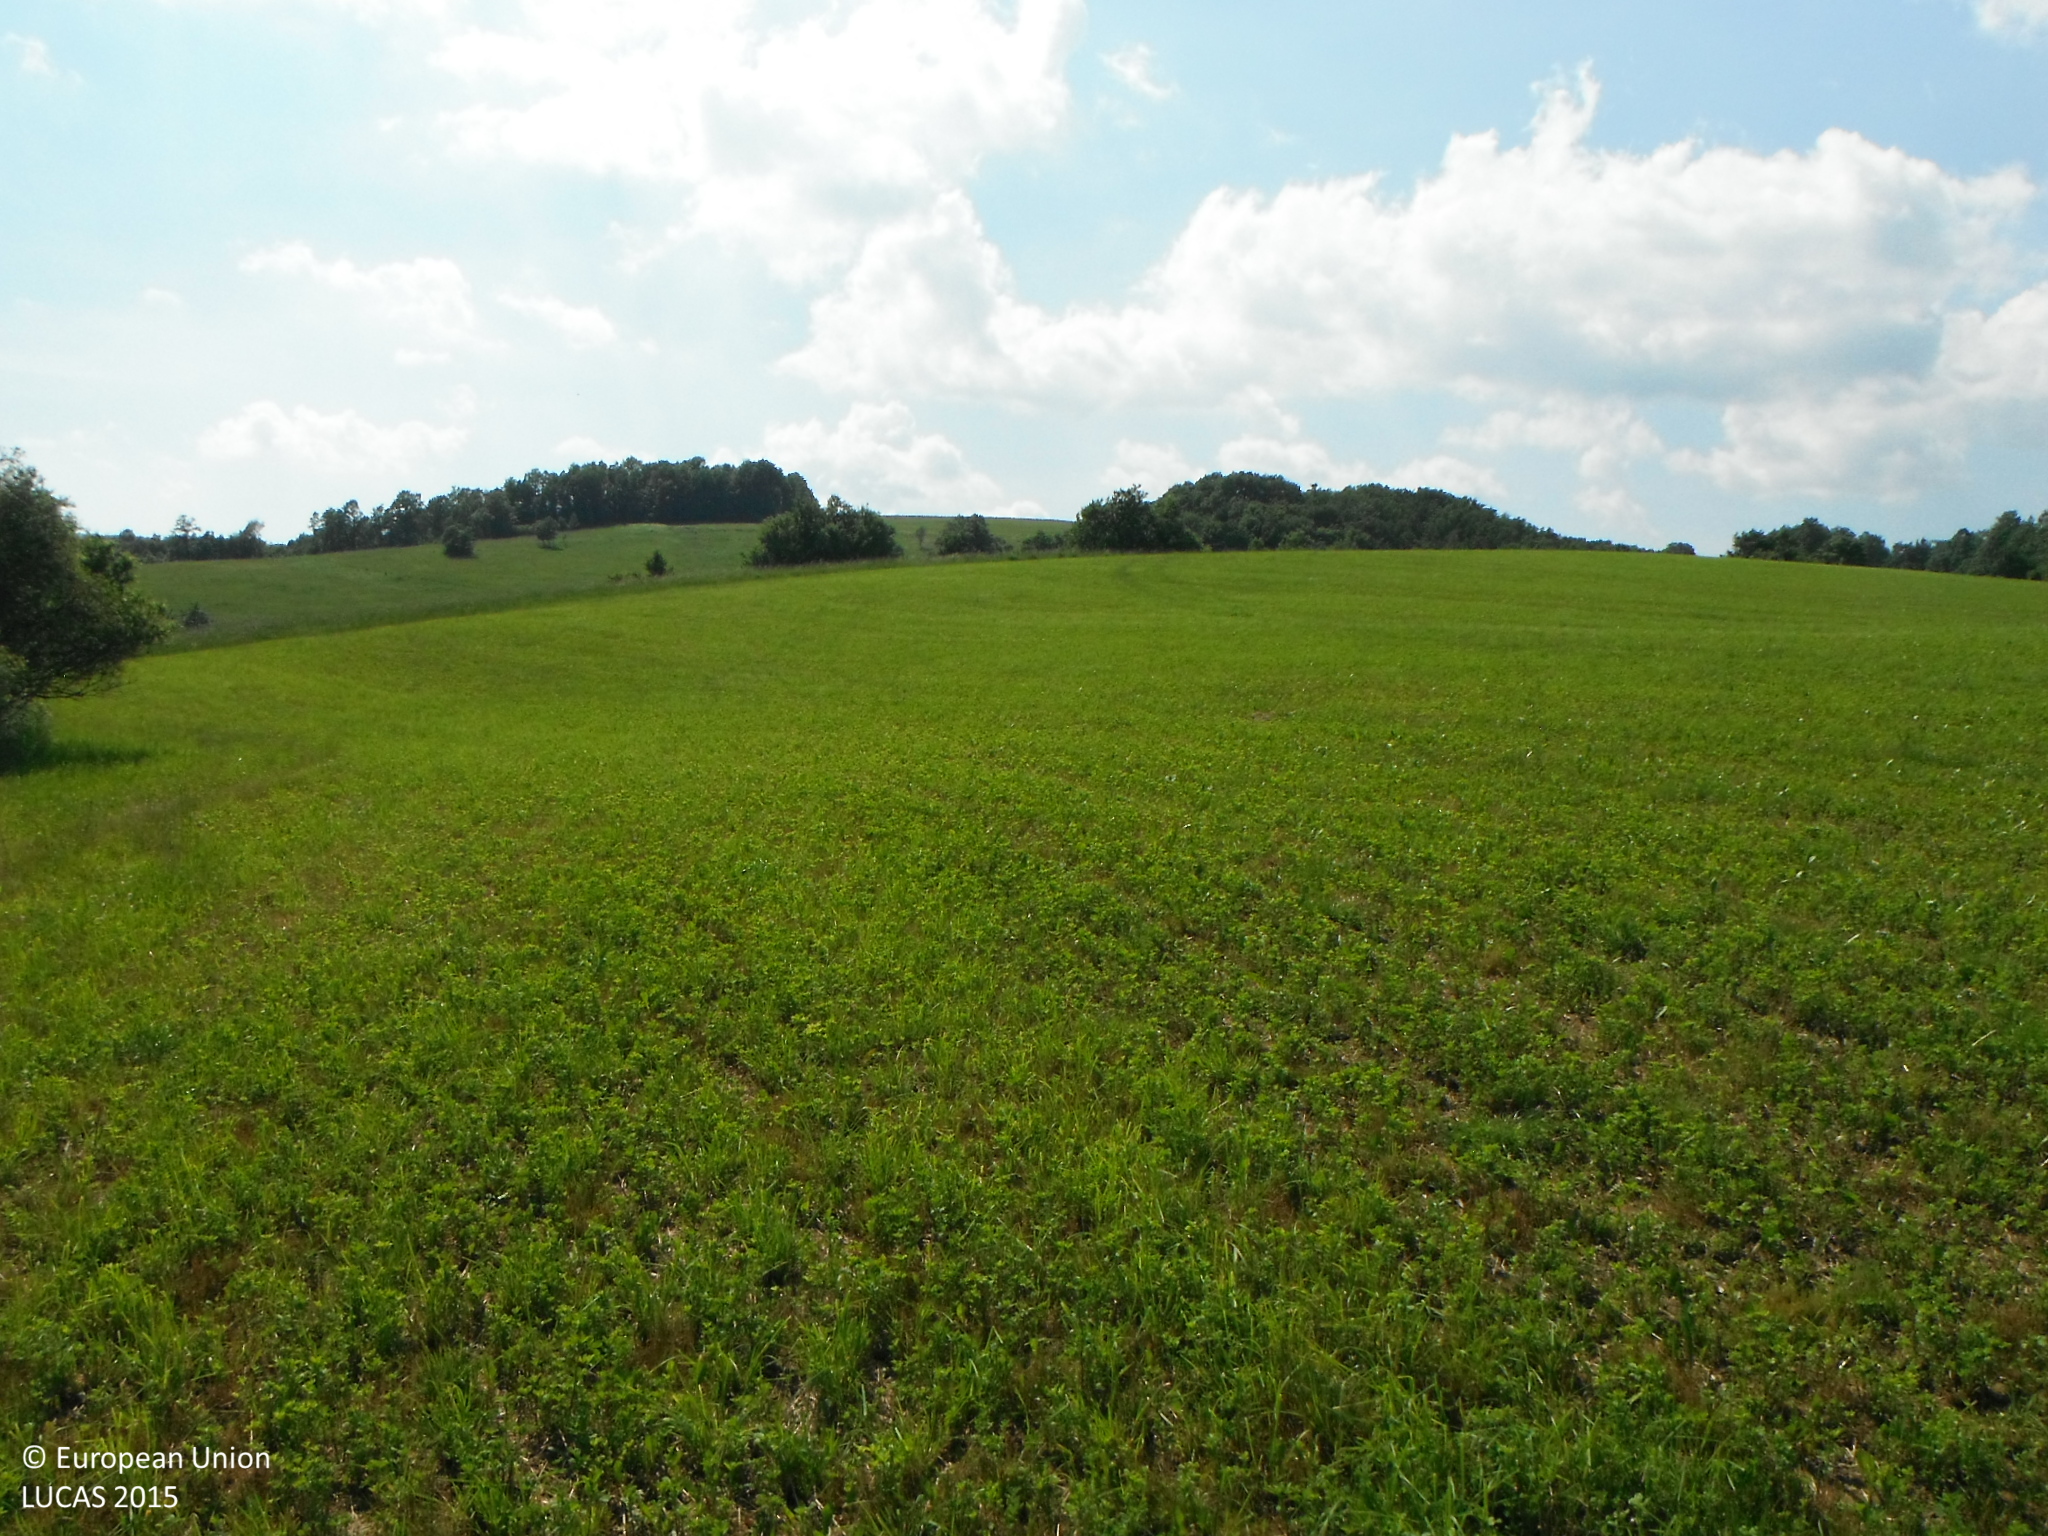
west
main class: Cropland
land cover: Other leguminous and mixtures for fodder
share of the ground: > 75 %
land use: Agriculture (excluding fallow land and kitchen gardens)
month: May
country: SK
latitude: 48.3507
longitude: 18.9122
